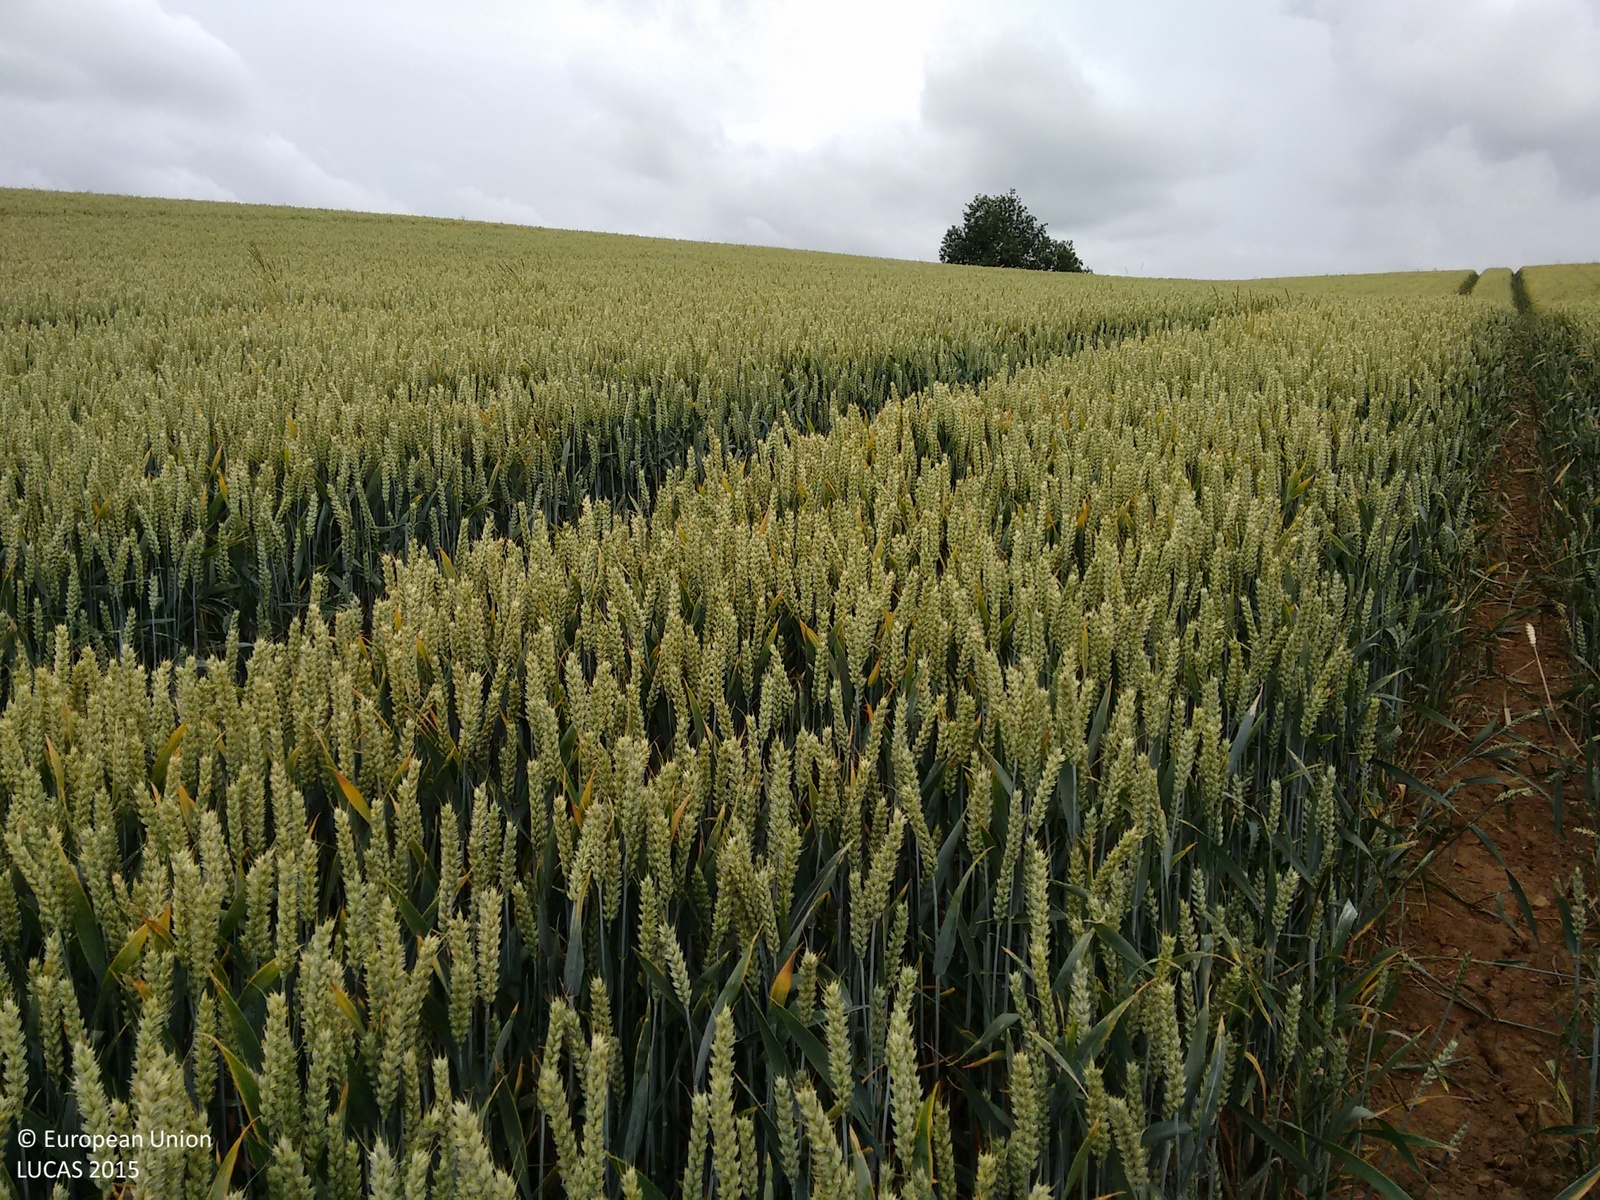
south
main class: Cropland
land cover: Common wheat
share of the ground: > 75 %
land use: Agriculture (excluding fallow land and kitchen gardens)
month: July
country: GB
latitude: 52.6126
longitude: -0.9576
